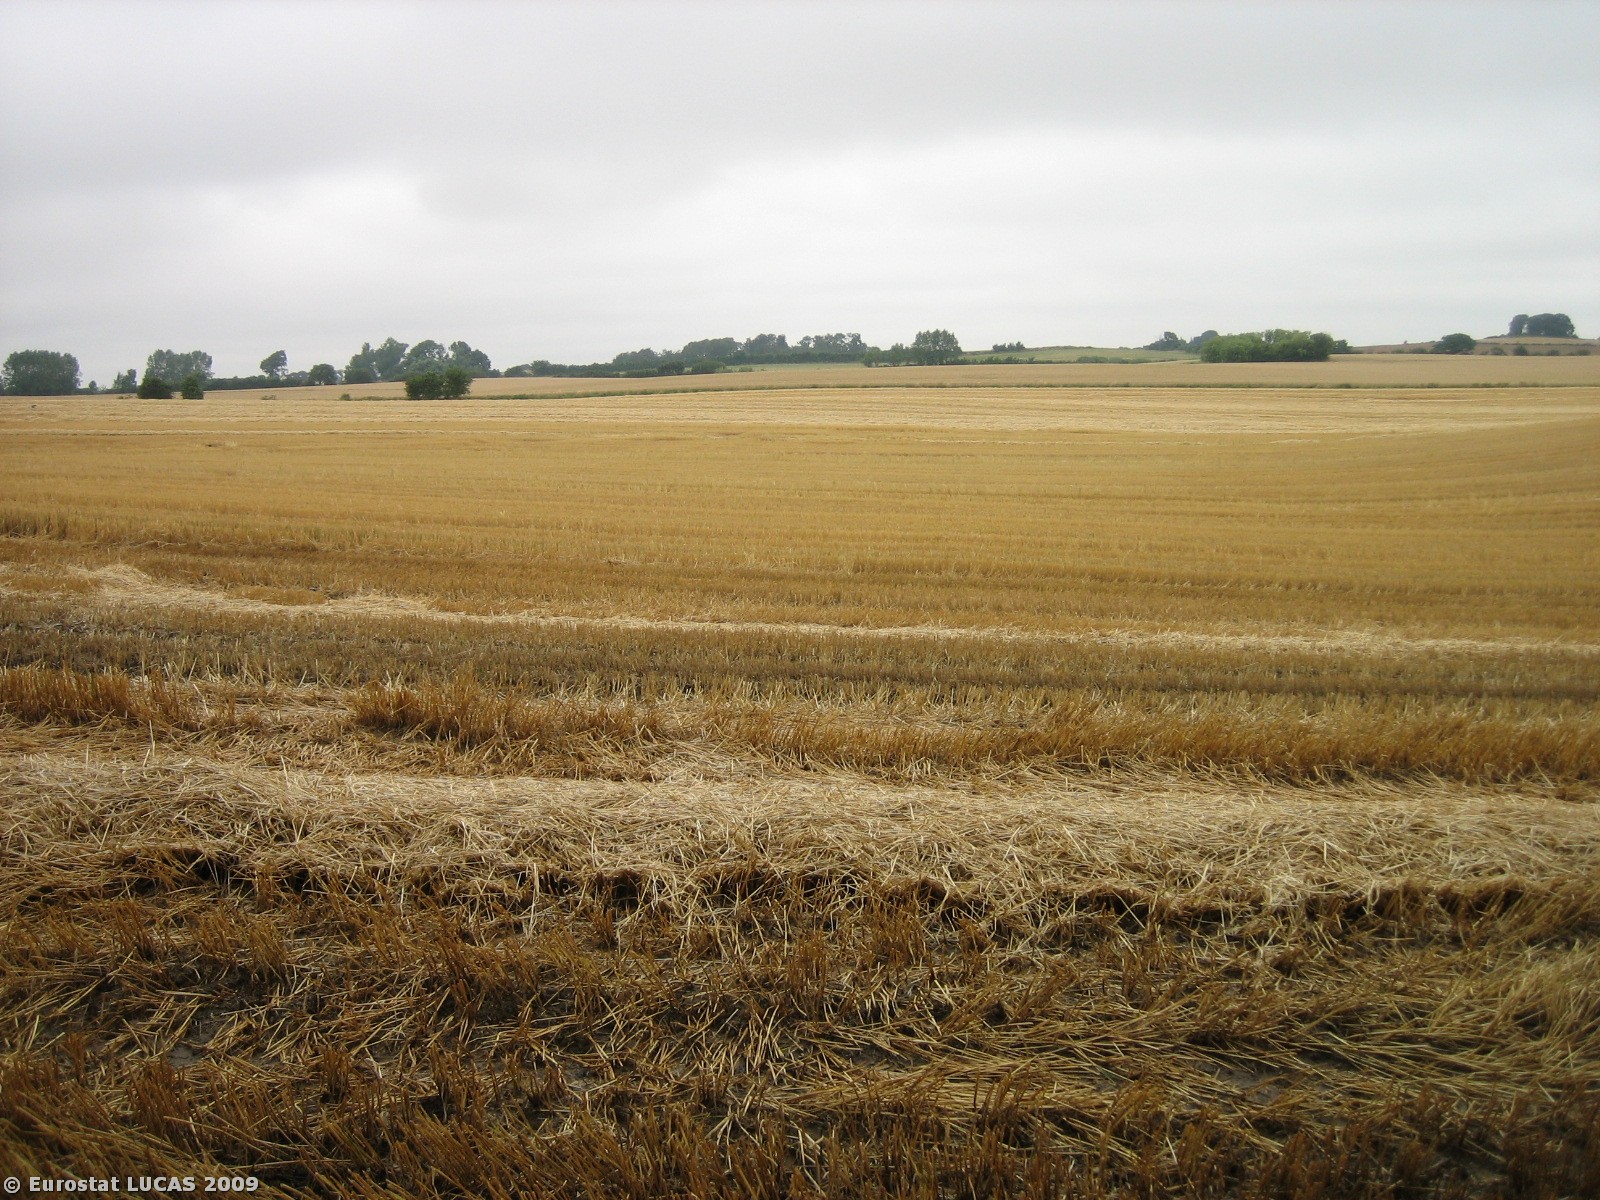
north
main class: Grassland
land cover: Grassland without tree/shrub cover
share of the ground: > 75 %
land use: Unused
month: July
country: DK
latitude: 55.2710
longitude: 9.9843
